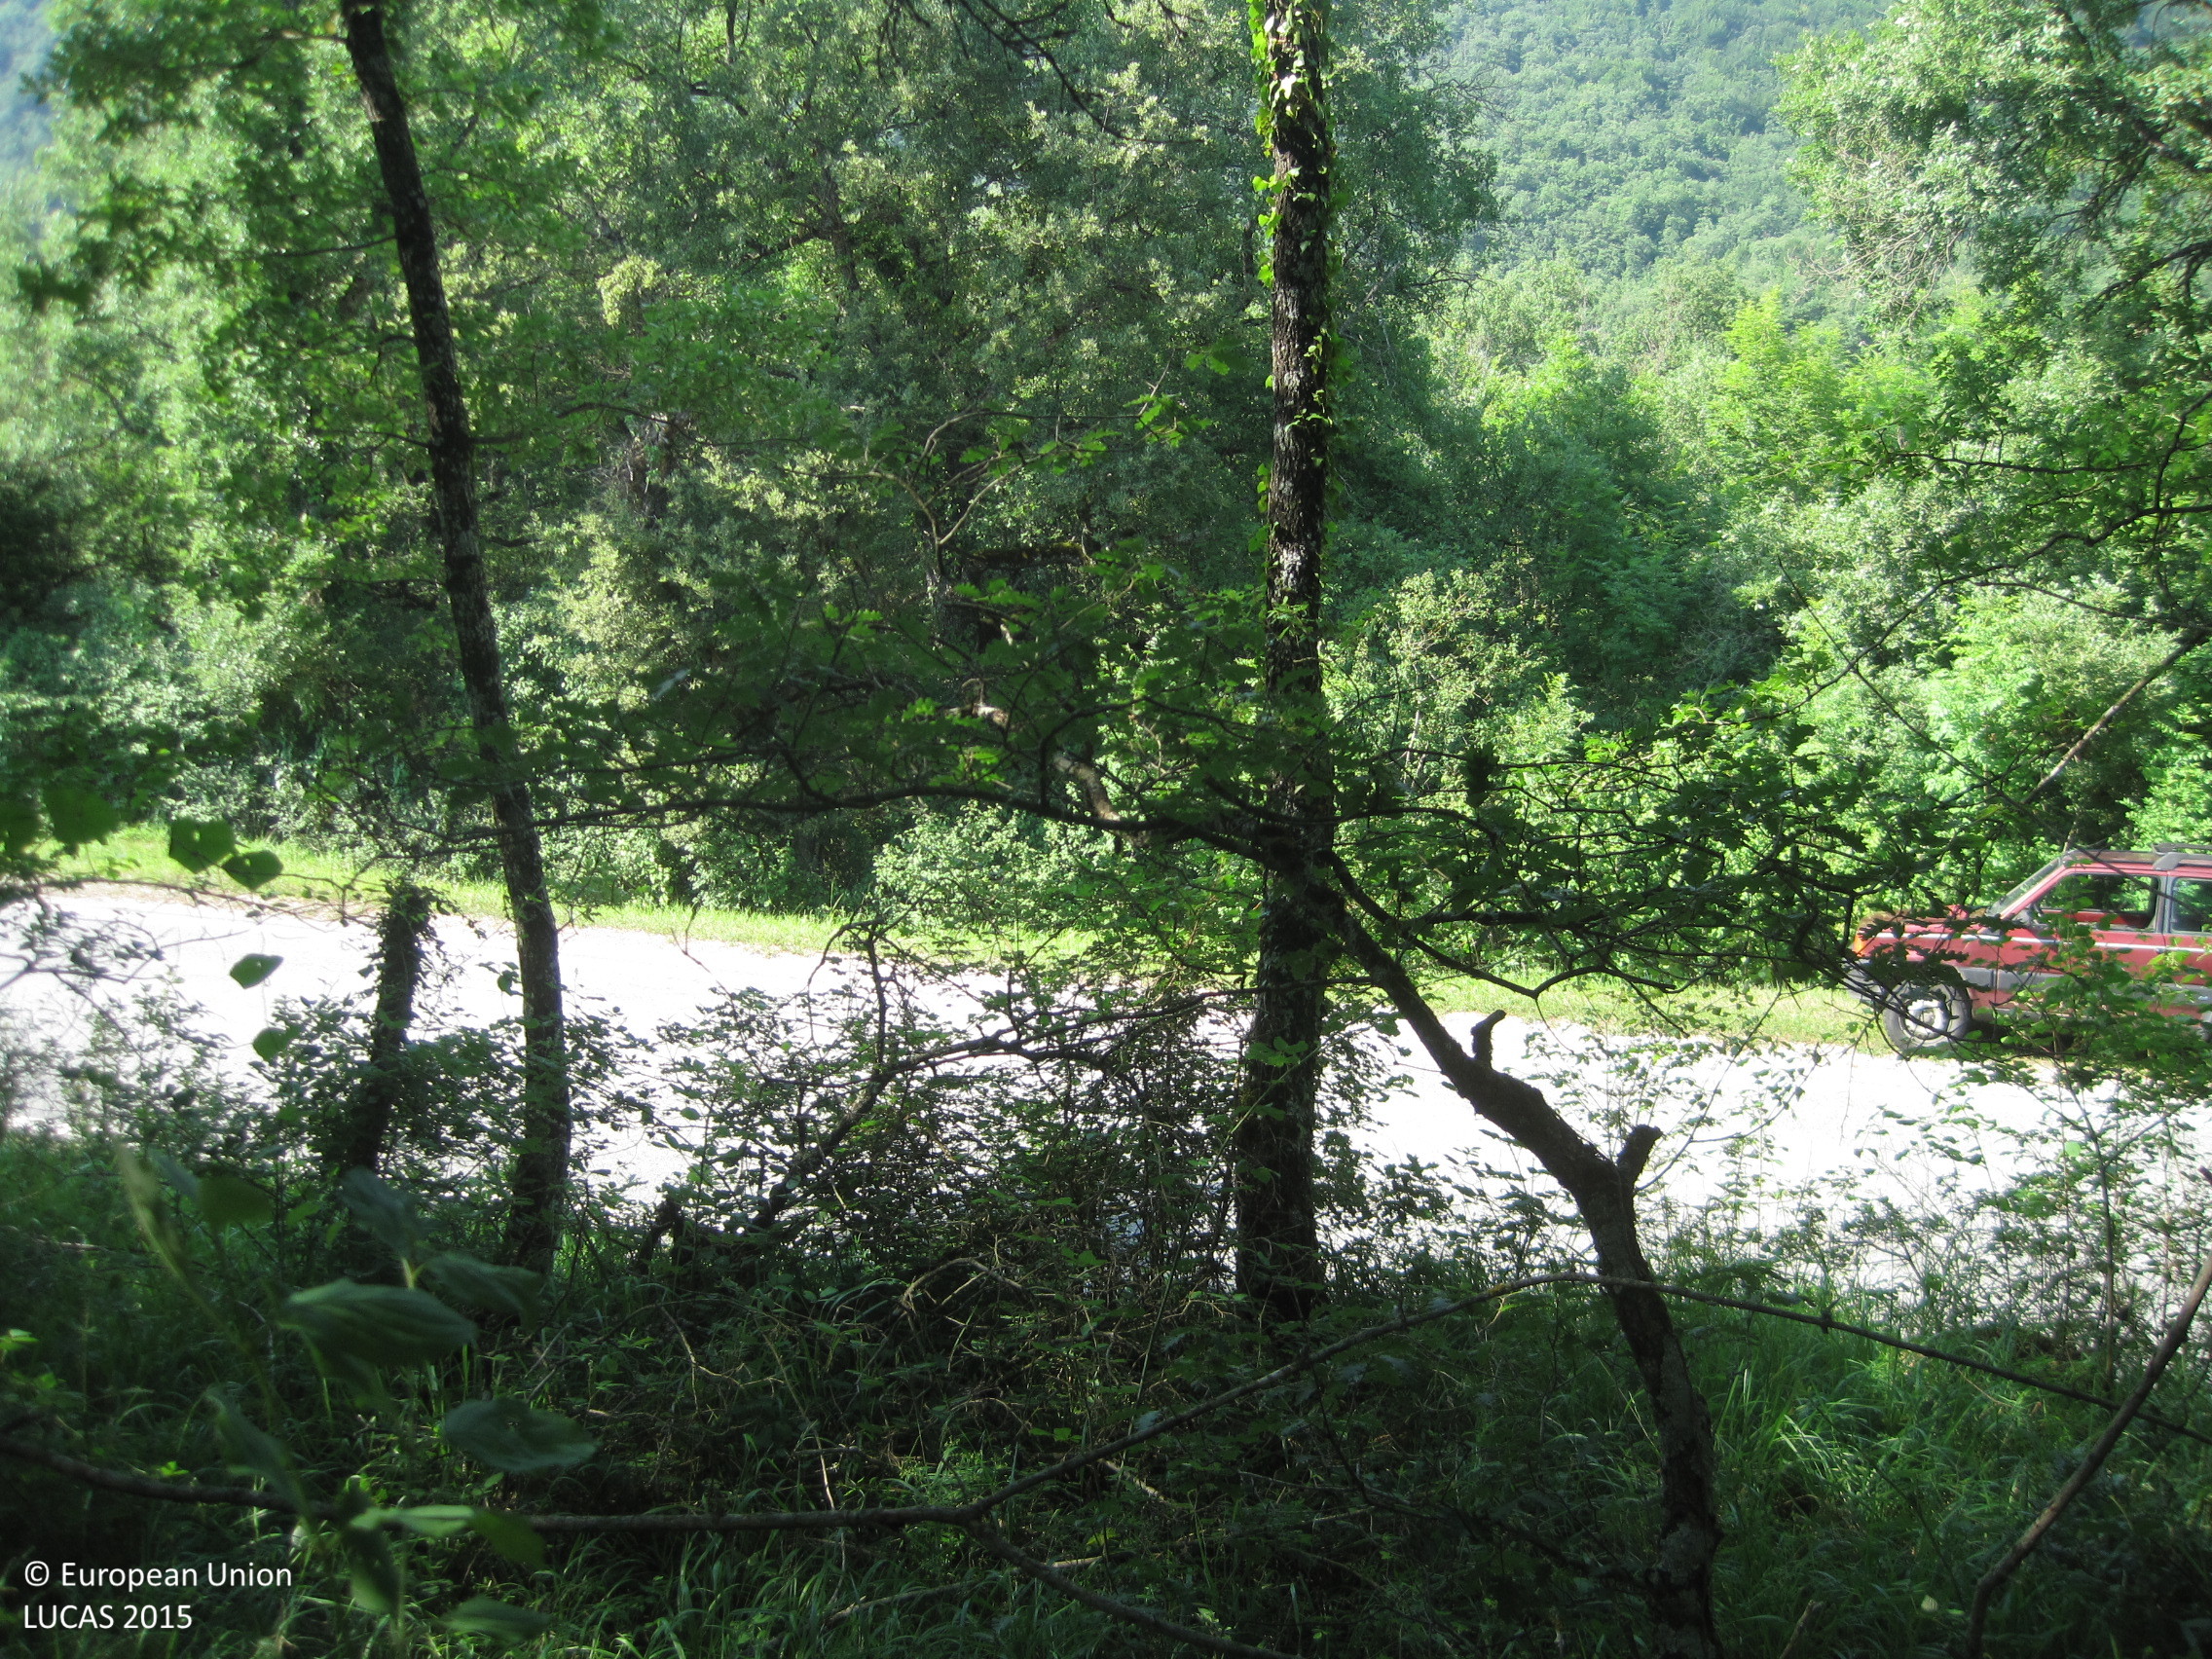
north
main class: Woodland
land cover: Broadleaved woodland
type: acidophilous oak and oak-birch forest
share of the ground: > 75 %
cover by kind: broadleaved forest trees 100 %
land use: Forestry
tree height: > 5 m
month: June
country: ES
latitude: 42.9316
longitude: -1.7677
